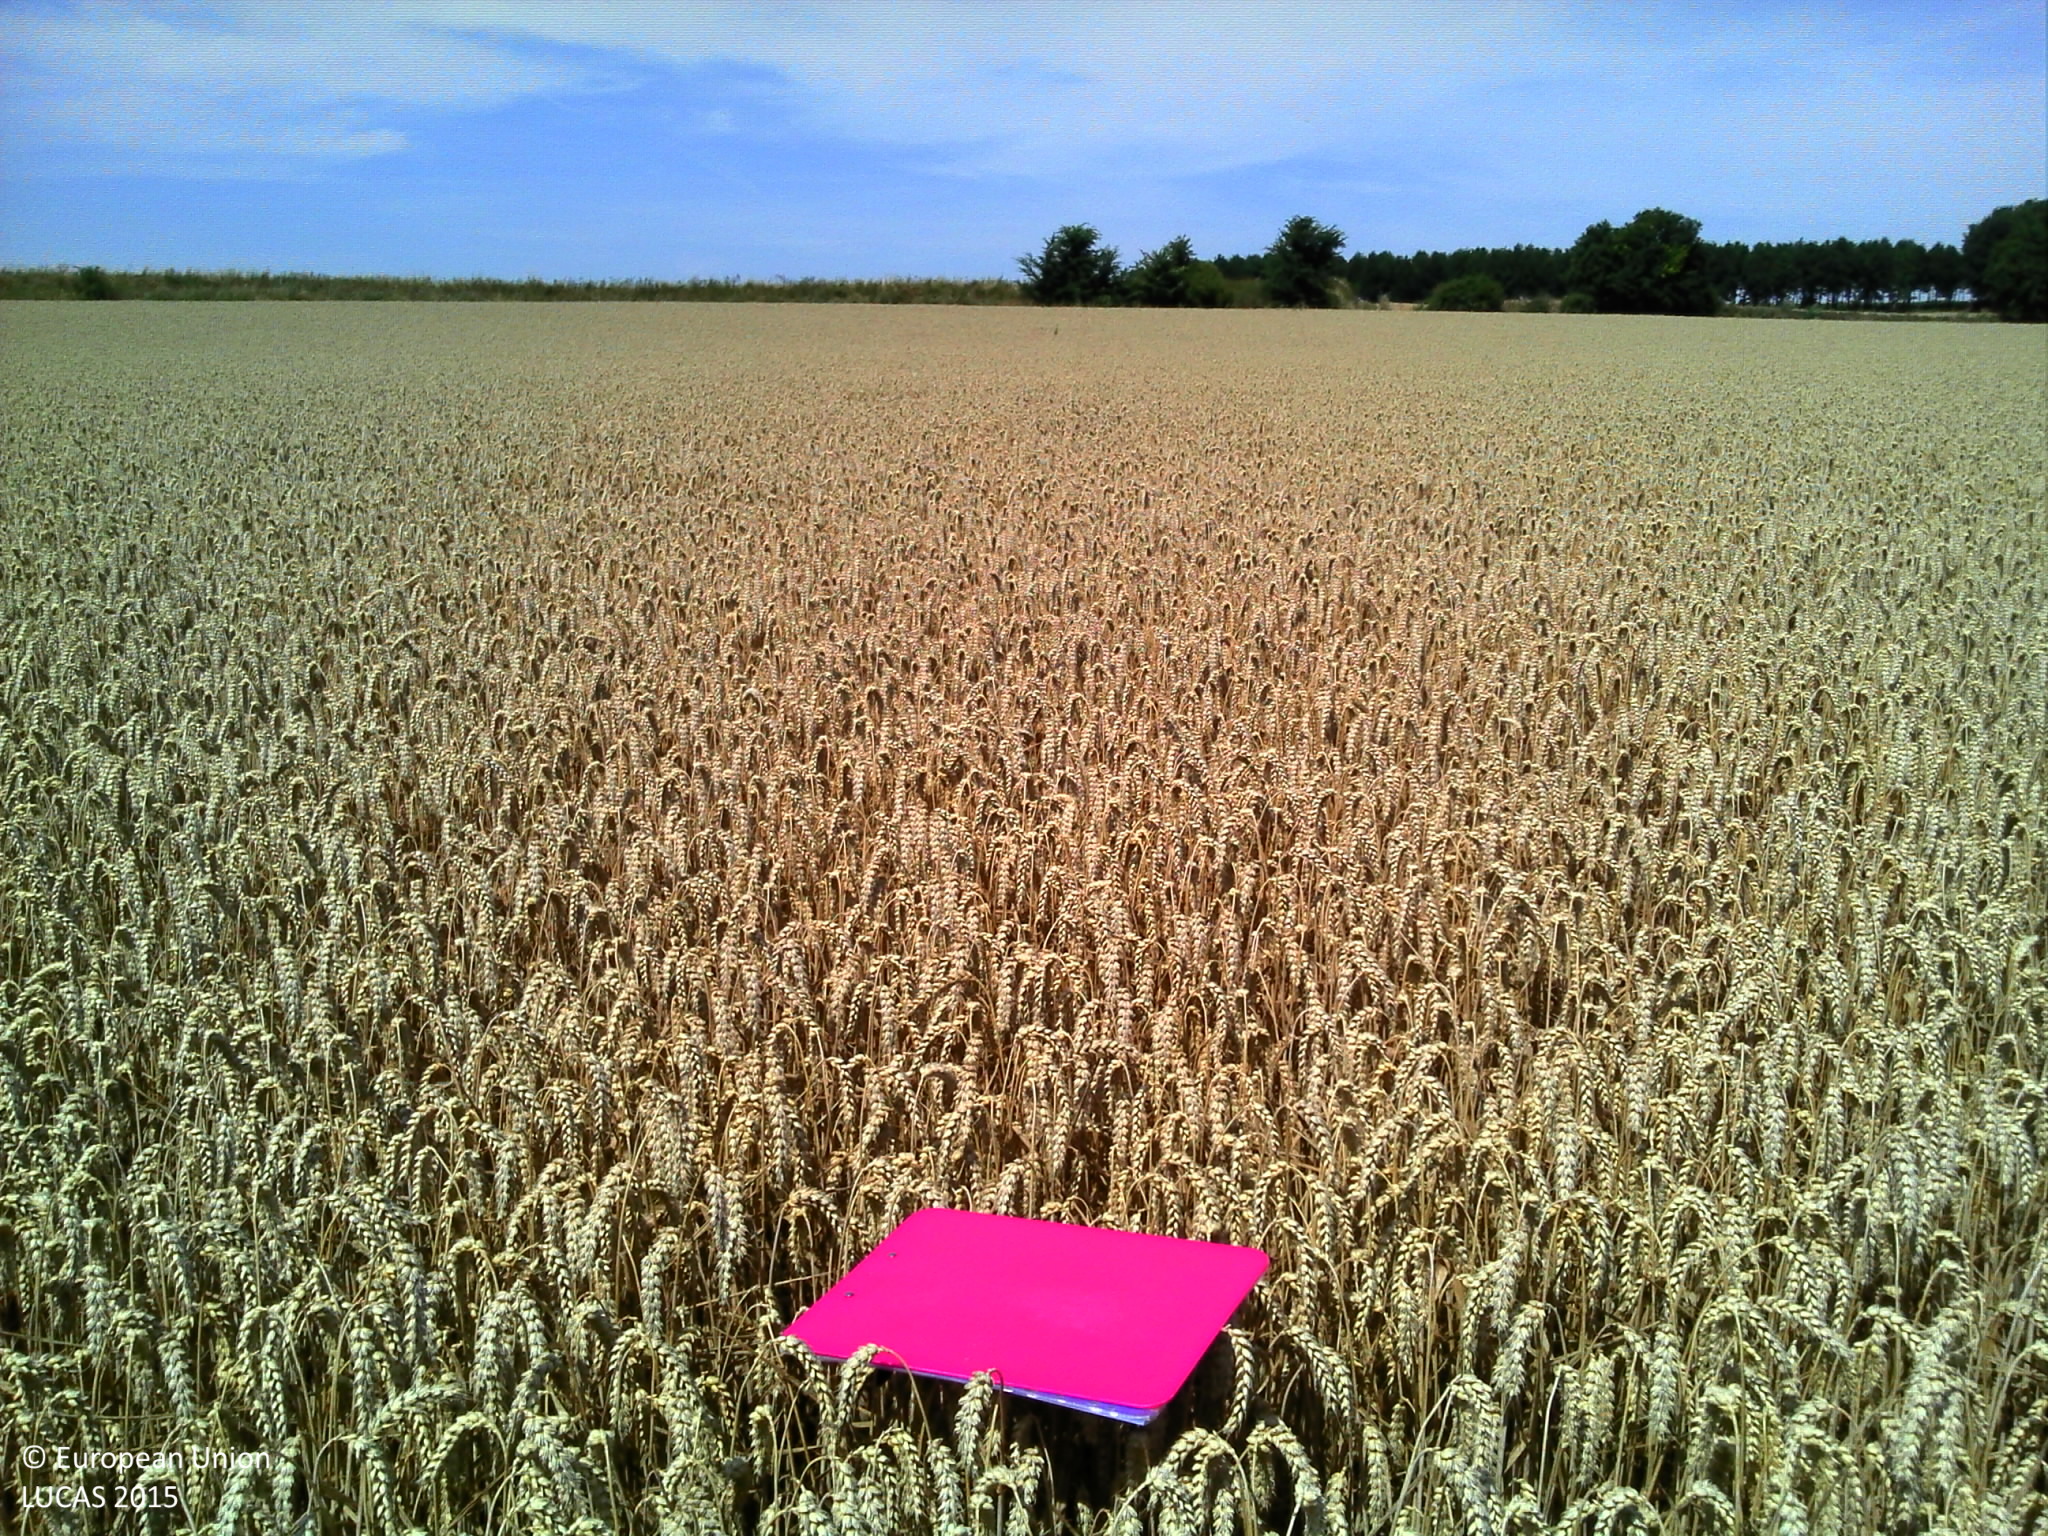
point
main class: Cropland
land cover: Common wheat
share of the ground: > 75 %
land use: Agriculture (excluding fallow land and kitchen gardens)
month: August
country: FR
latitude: 50.2998
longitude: 3.0975
